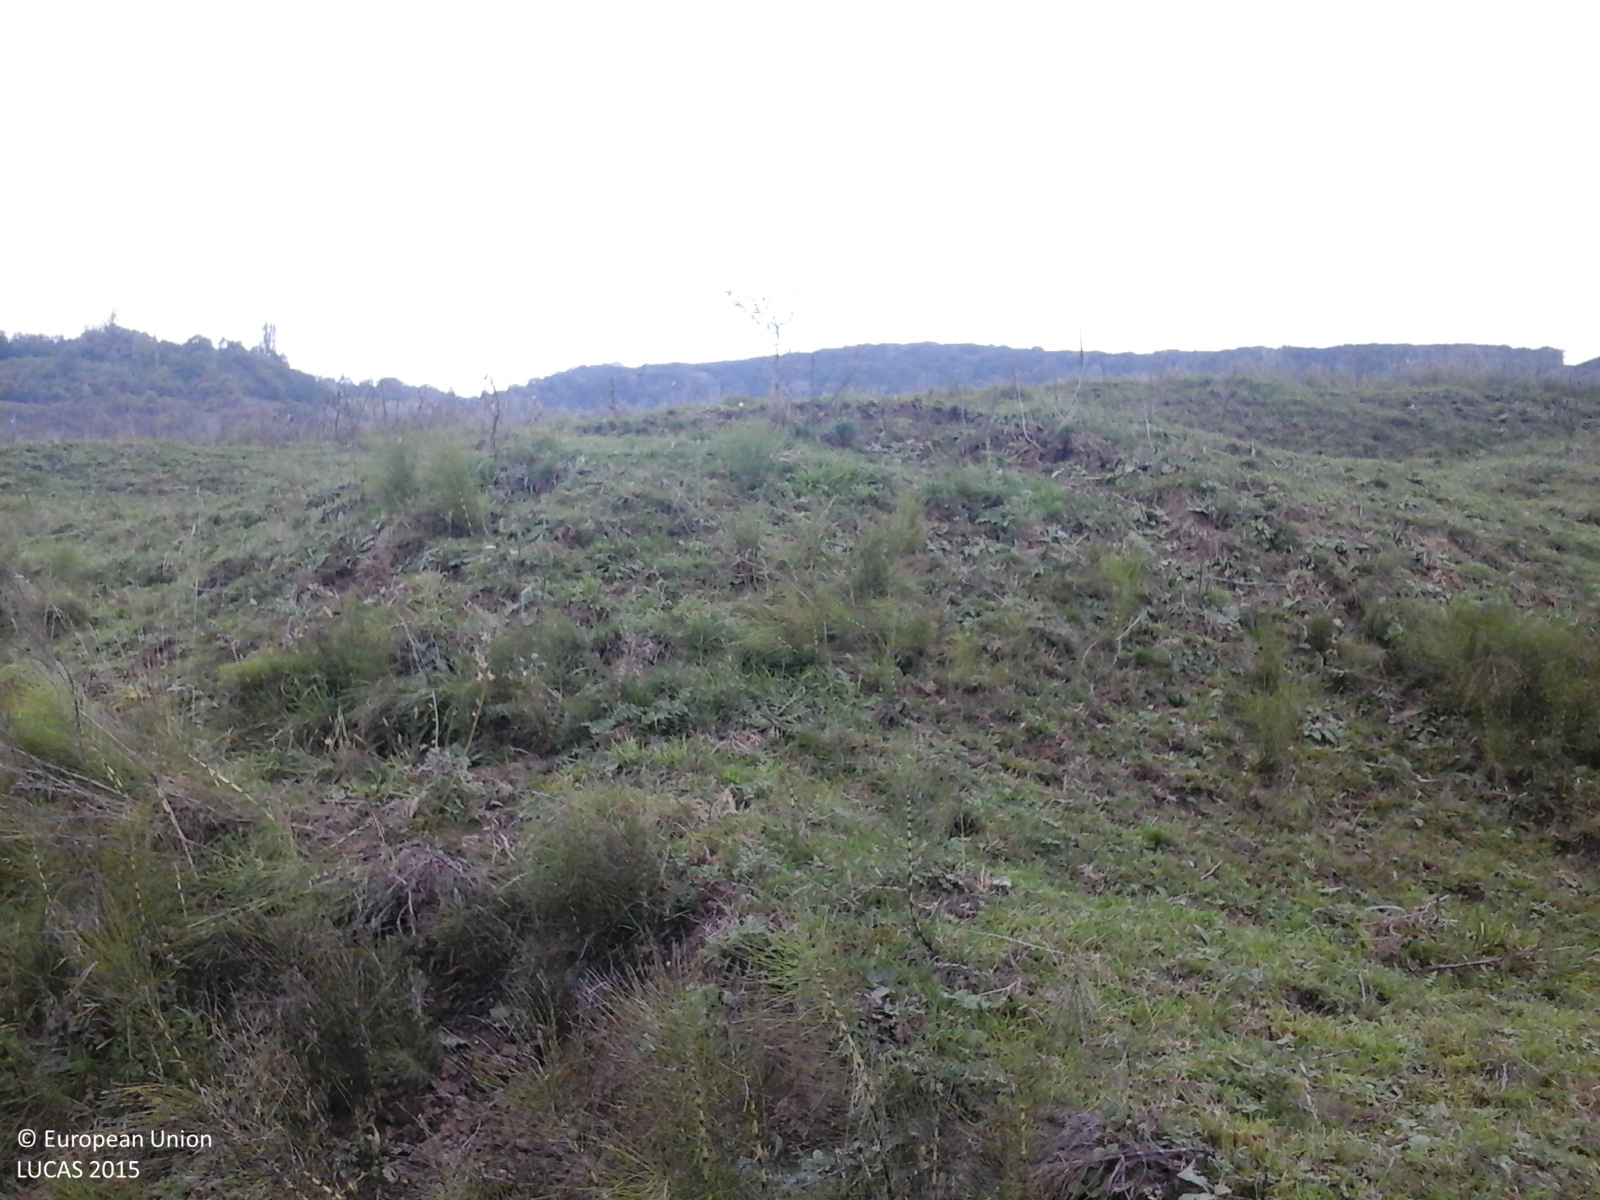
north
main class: Grassland
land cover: Grassland with sparse tree/shrub cover
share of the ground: > 75 %
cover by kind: herbaceous plants 85 %, shrubs 10 %, broadleaved forest trees 5 %
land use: Agriculture (excluding fallow land and kitchen gardens)
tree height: < 5 m
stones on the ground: 10 - 25 %
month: October
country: RO
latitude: 46.3477
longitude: 25.0005
